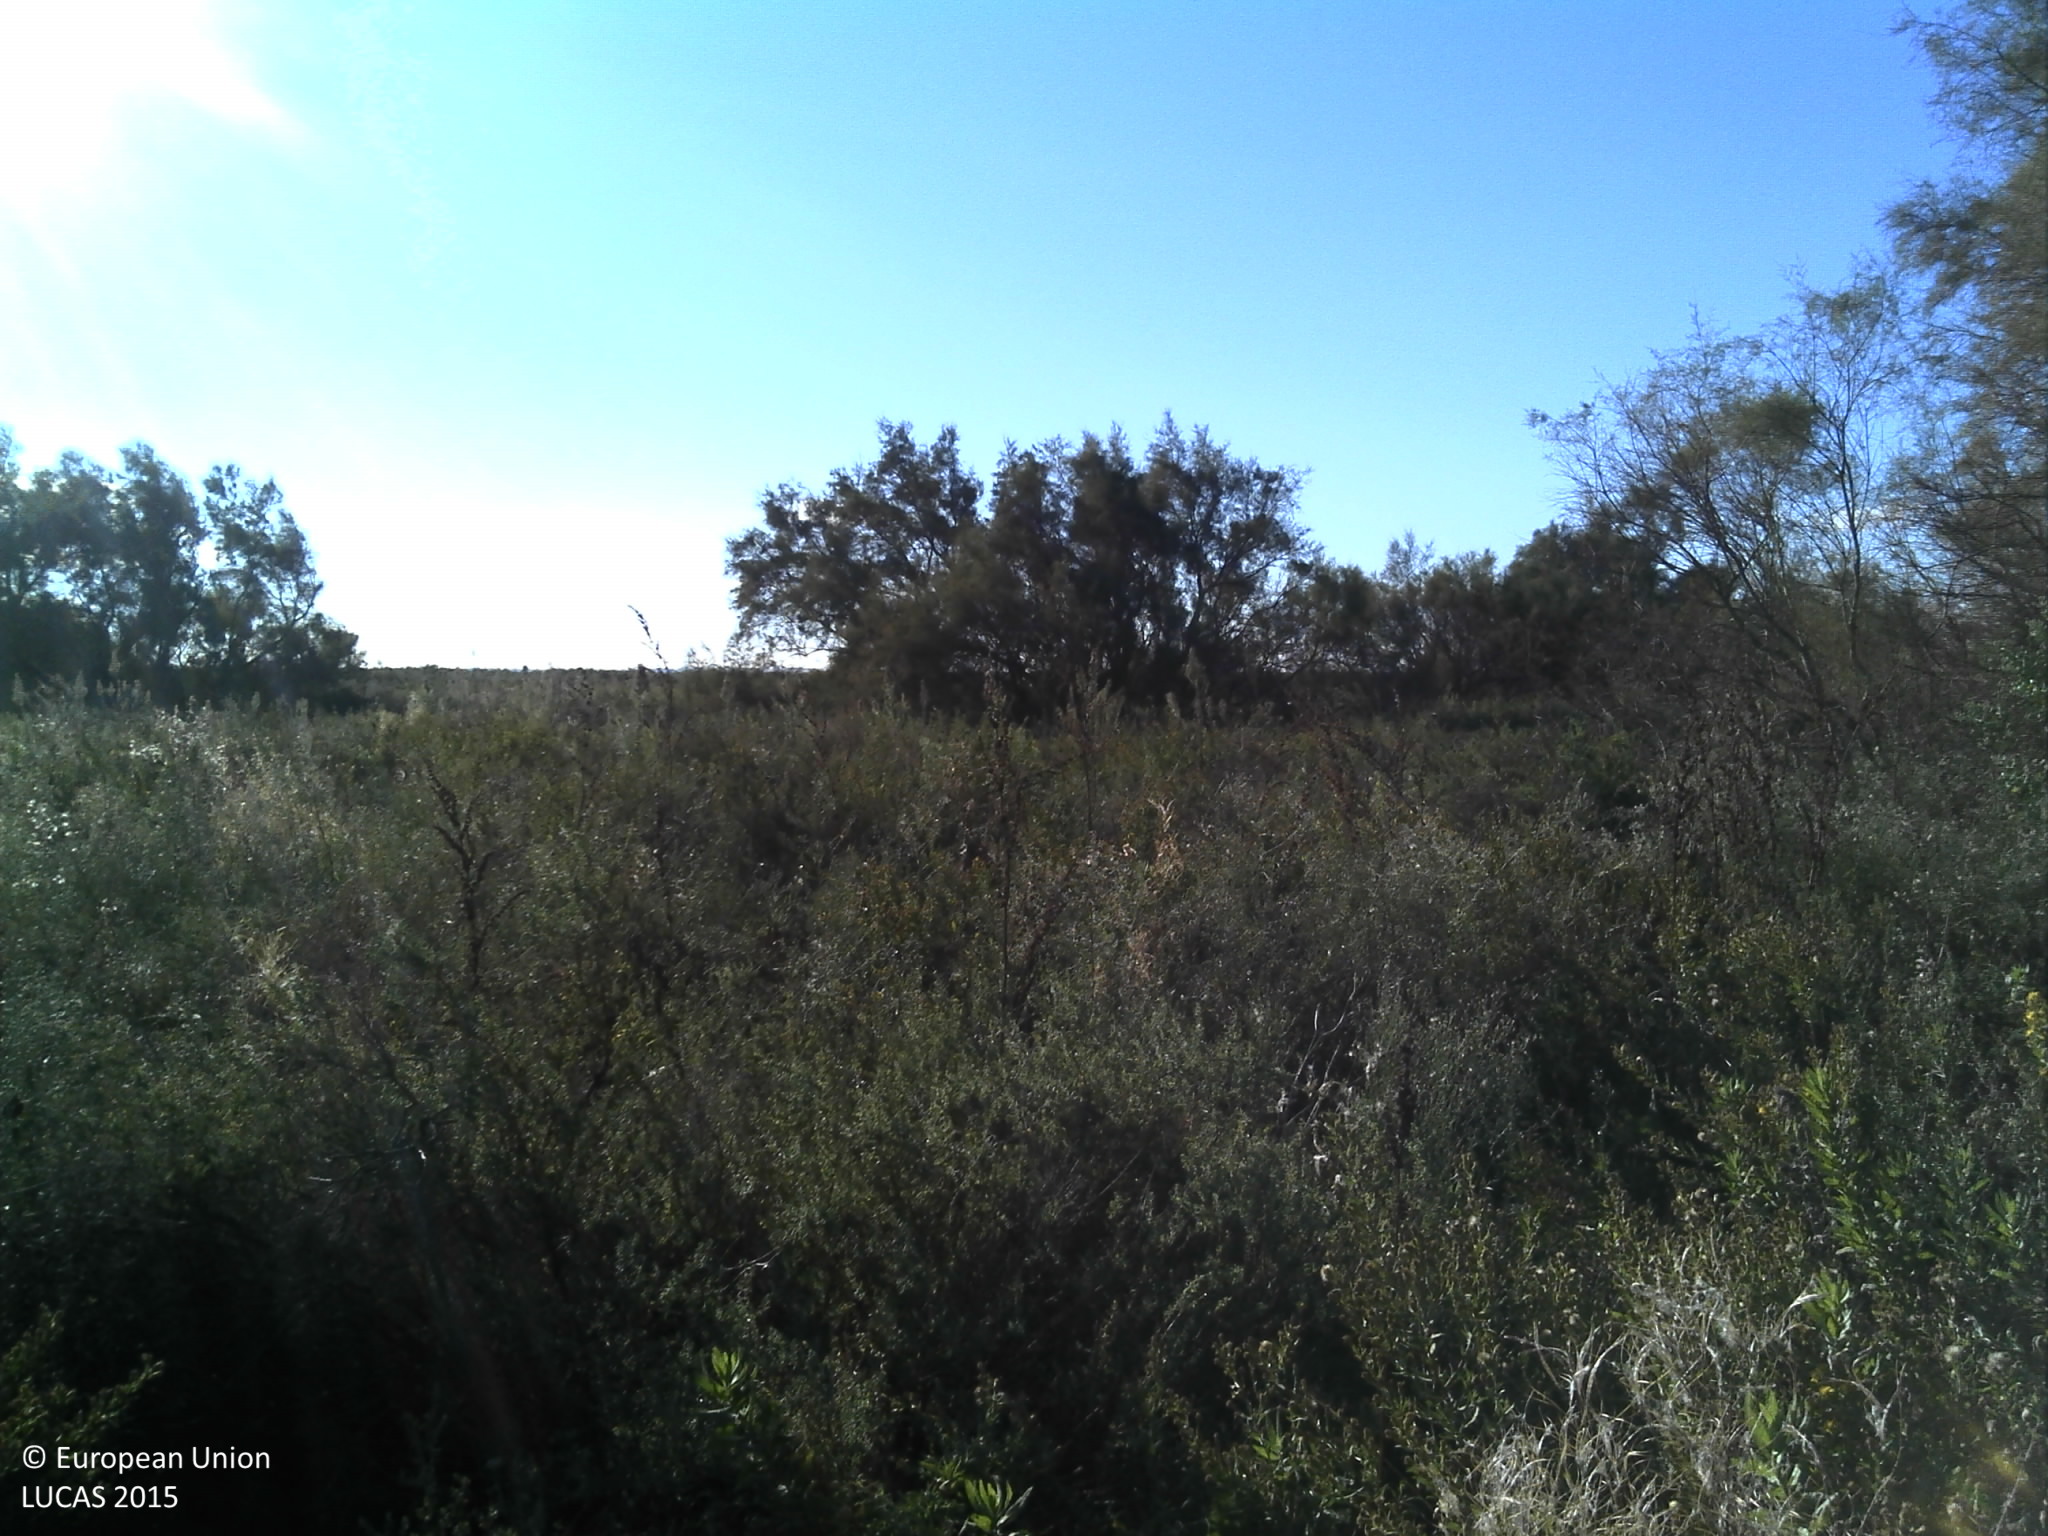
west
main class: Woodland
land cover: Other coniferous woodland
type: thermophilous deciduous forest
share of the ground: 50 - 75 %
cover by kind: coniferous forest trees 60 %, shrubs 20 %, broadleaved forest trees 10 %, herbaceous plants 10 %
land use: Forestry
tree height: > 5 m
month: July
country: FR
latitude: 43.4446
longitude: 4.8329
